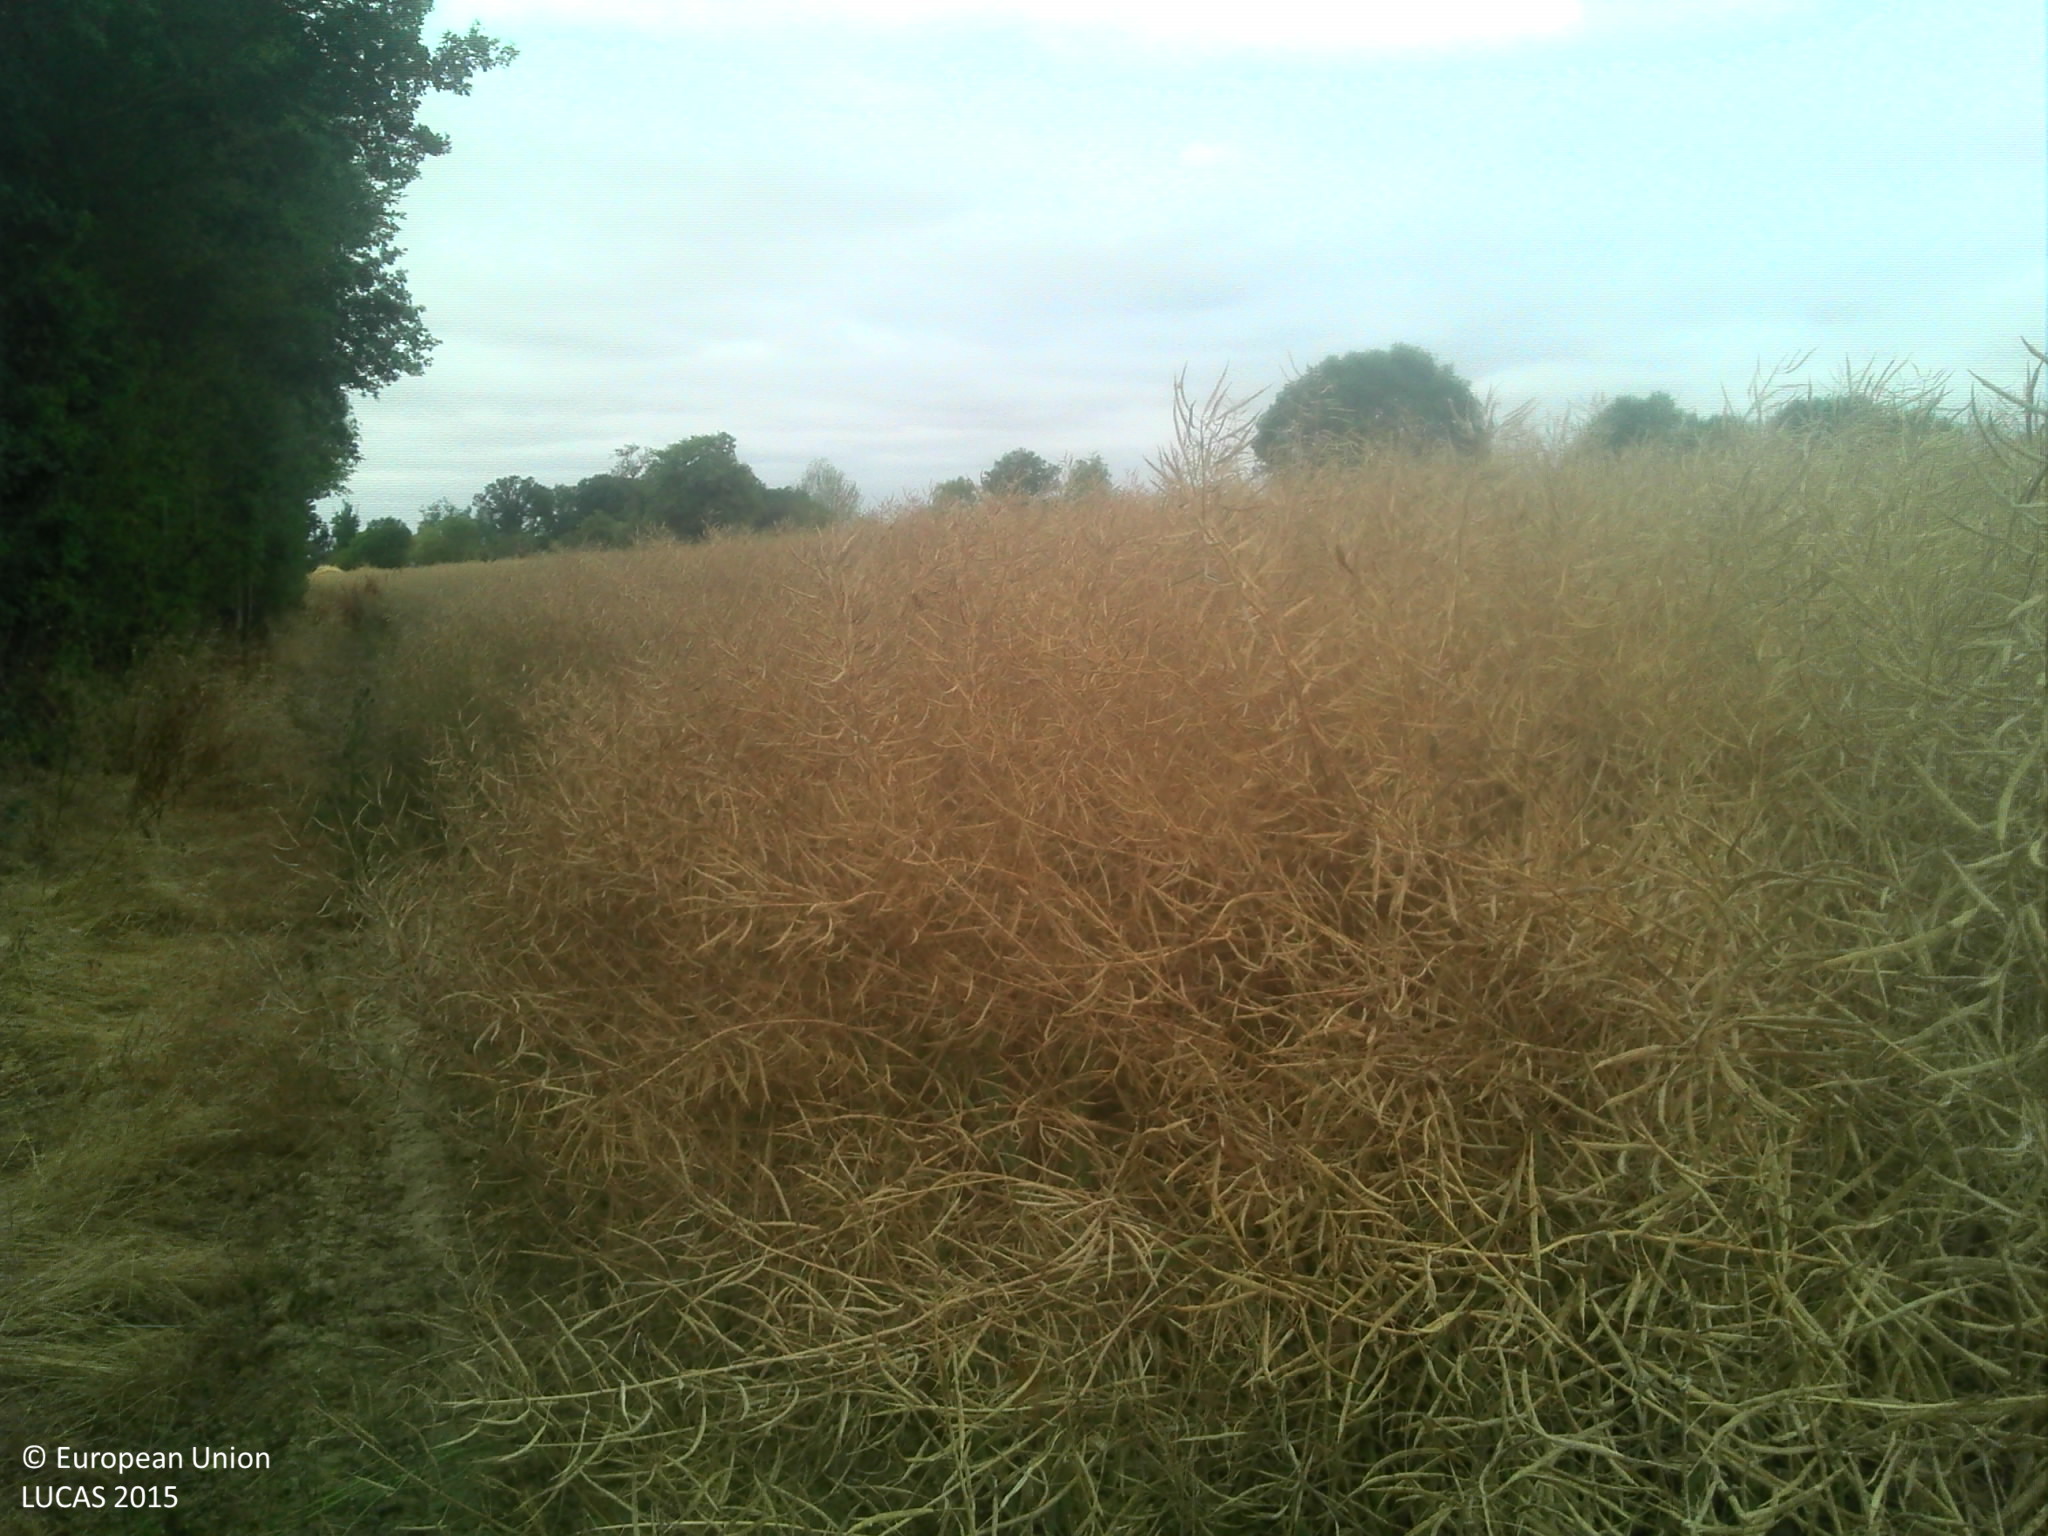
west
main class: Cropland
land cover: Rape and turnip rape
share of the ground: > 75 %
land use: Agriculture (excluding fallow land and kitchen gardens)
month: July
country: FR
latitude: 47.9338
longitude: 1.0803
